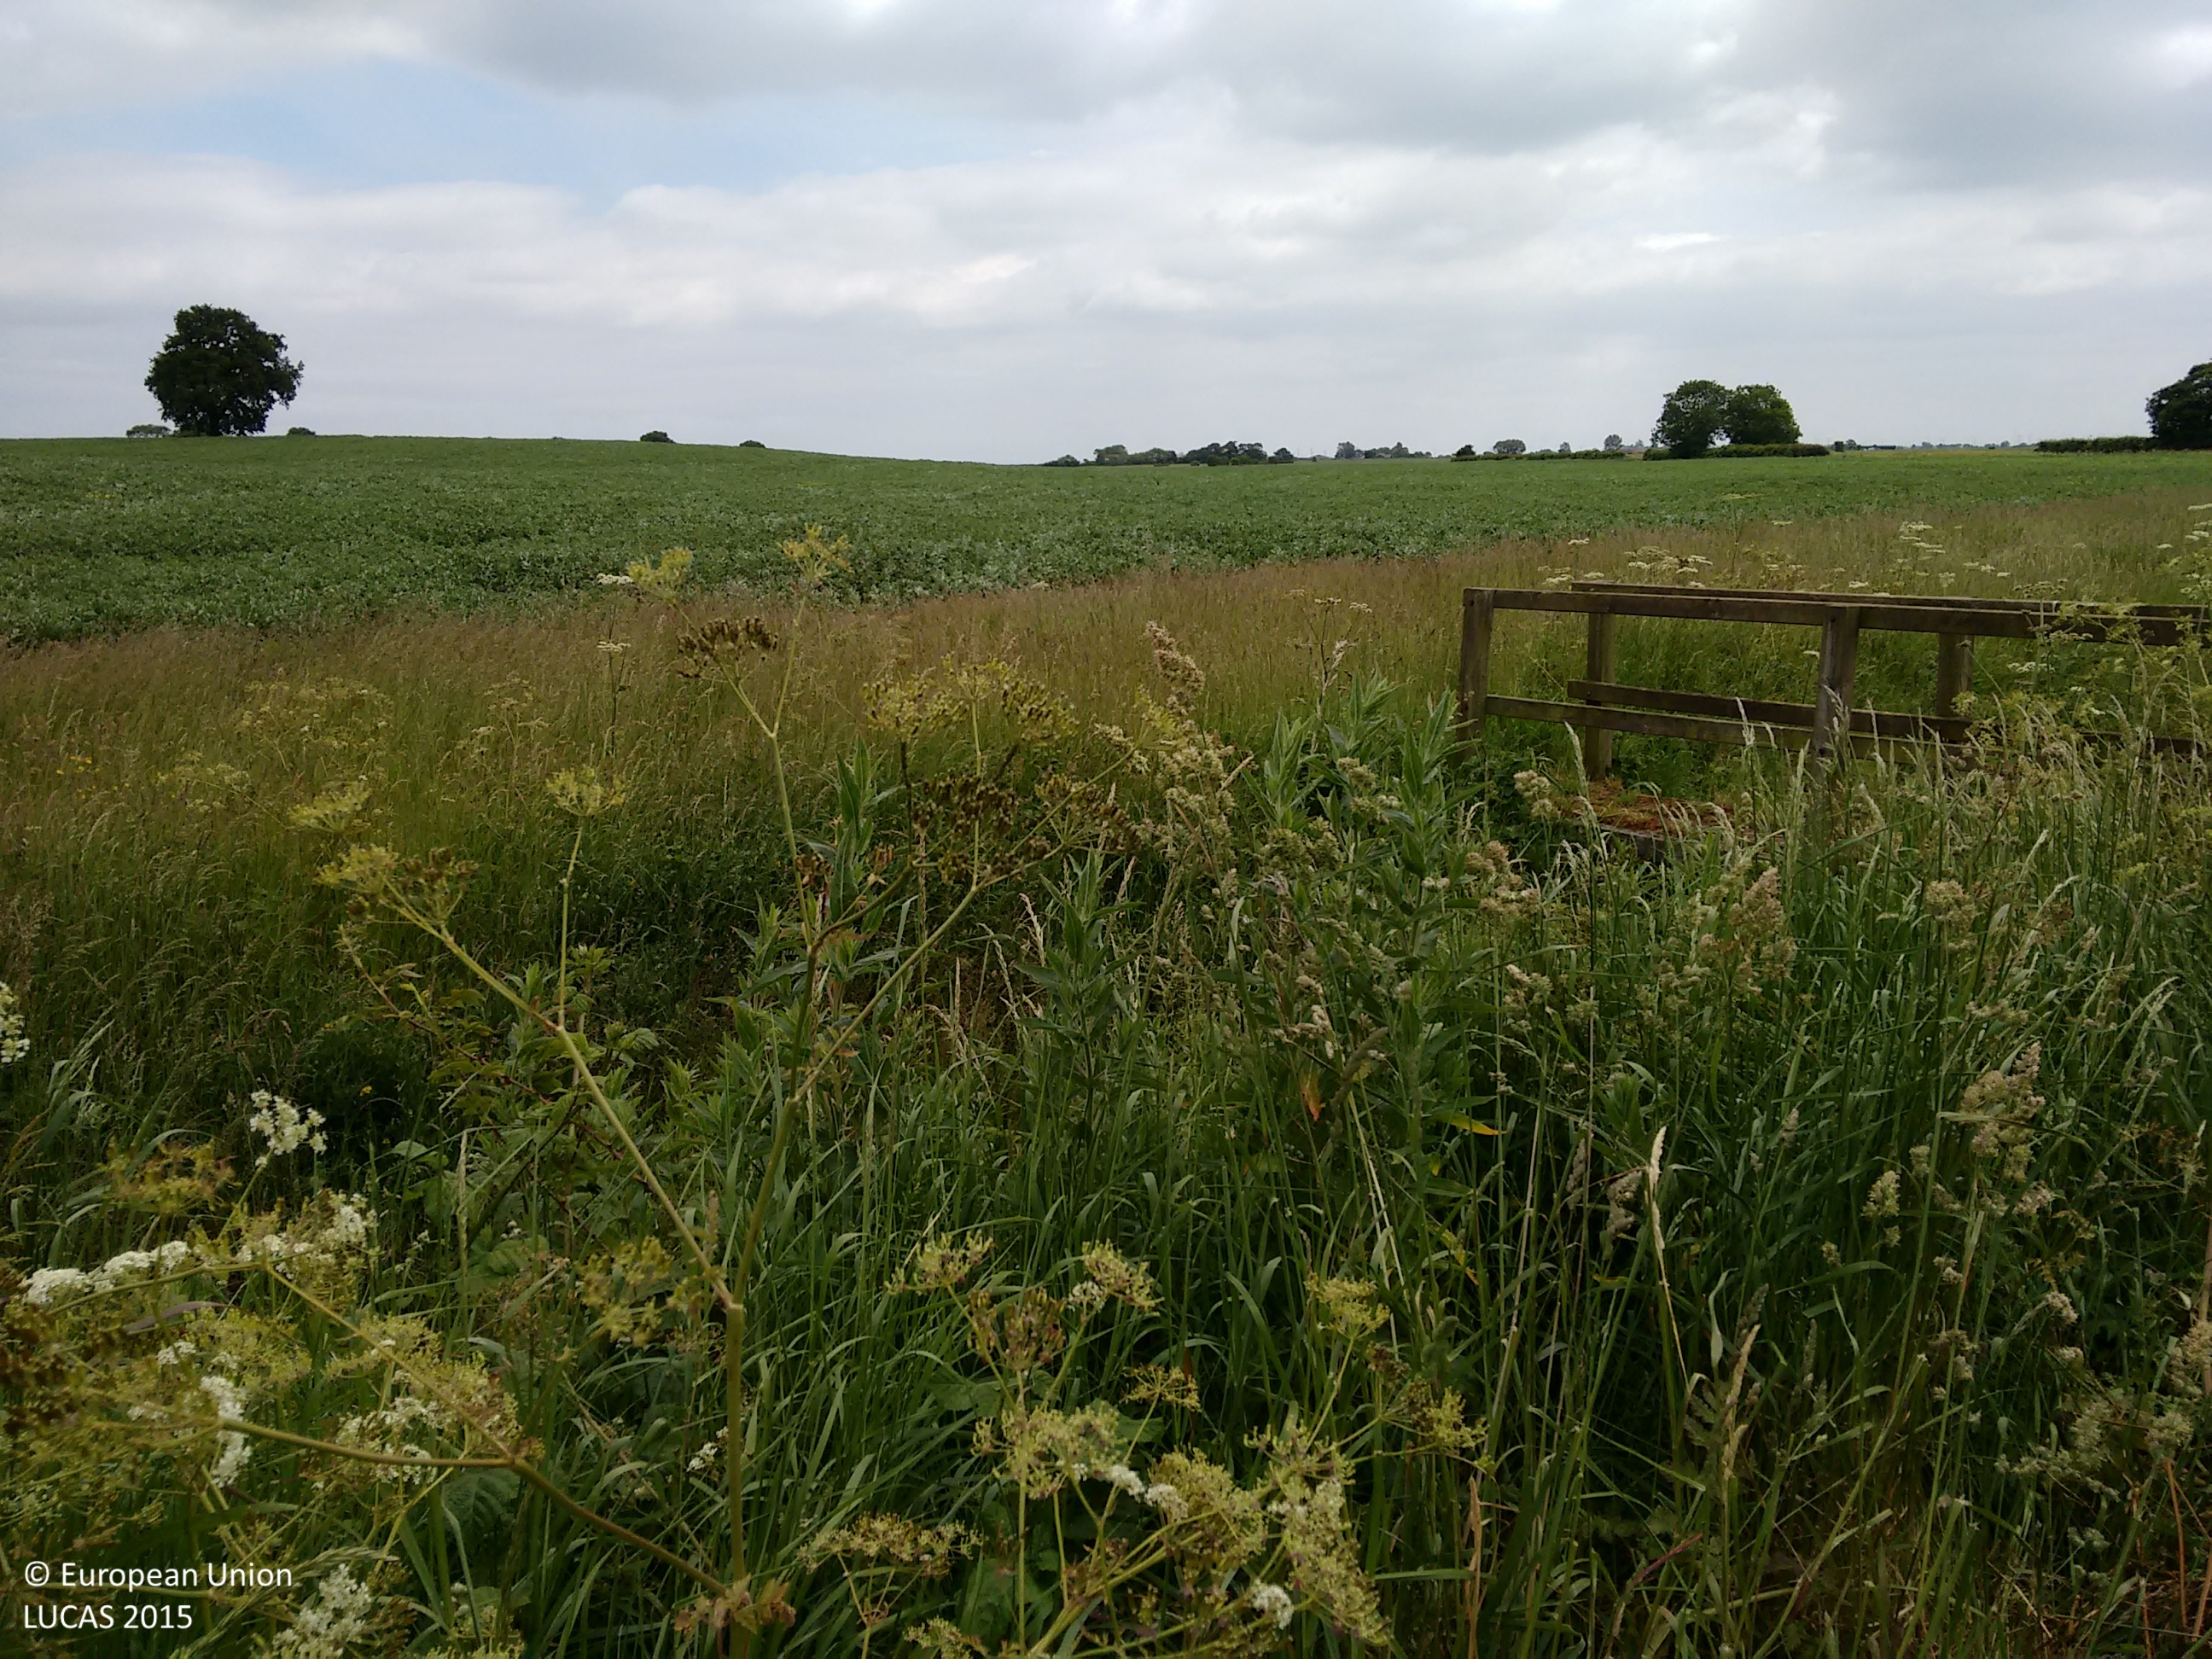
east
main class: Grassland
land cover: Grassland without tree/shrub cover
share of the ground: > 75 %
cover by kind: herbaceous plants 100 %
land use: Agriculture (excluding fallow land and kitchen gardens)
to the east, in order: Grass margins; Ditches and canals; Grassland without tree/shrub cover; Dry pulses; Grass margins
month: June
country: GB
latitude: 53.2451
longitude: 0.2751
